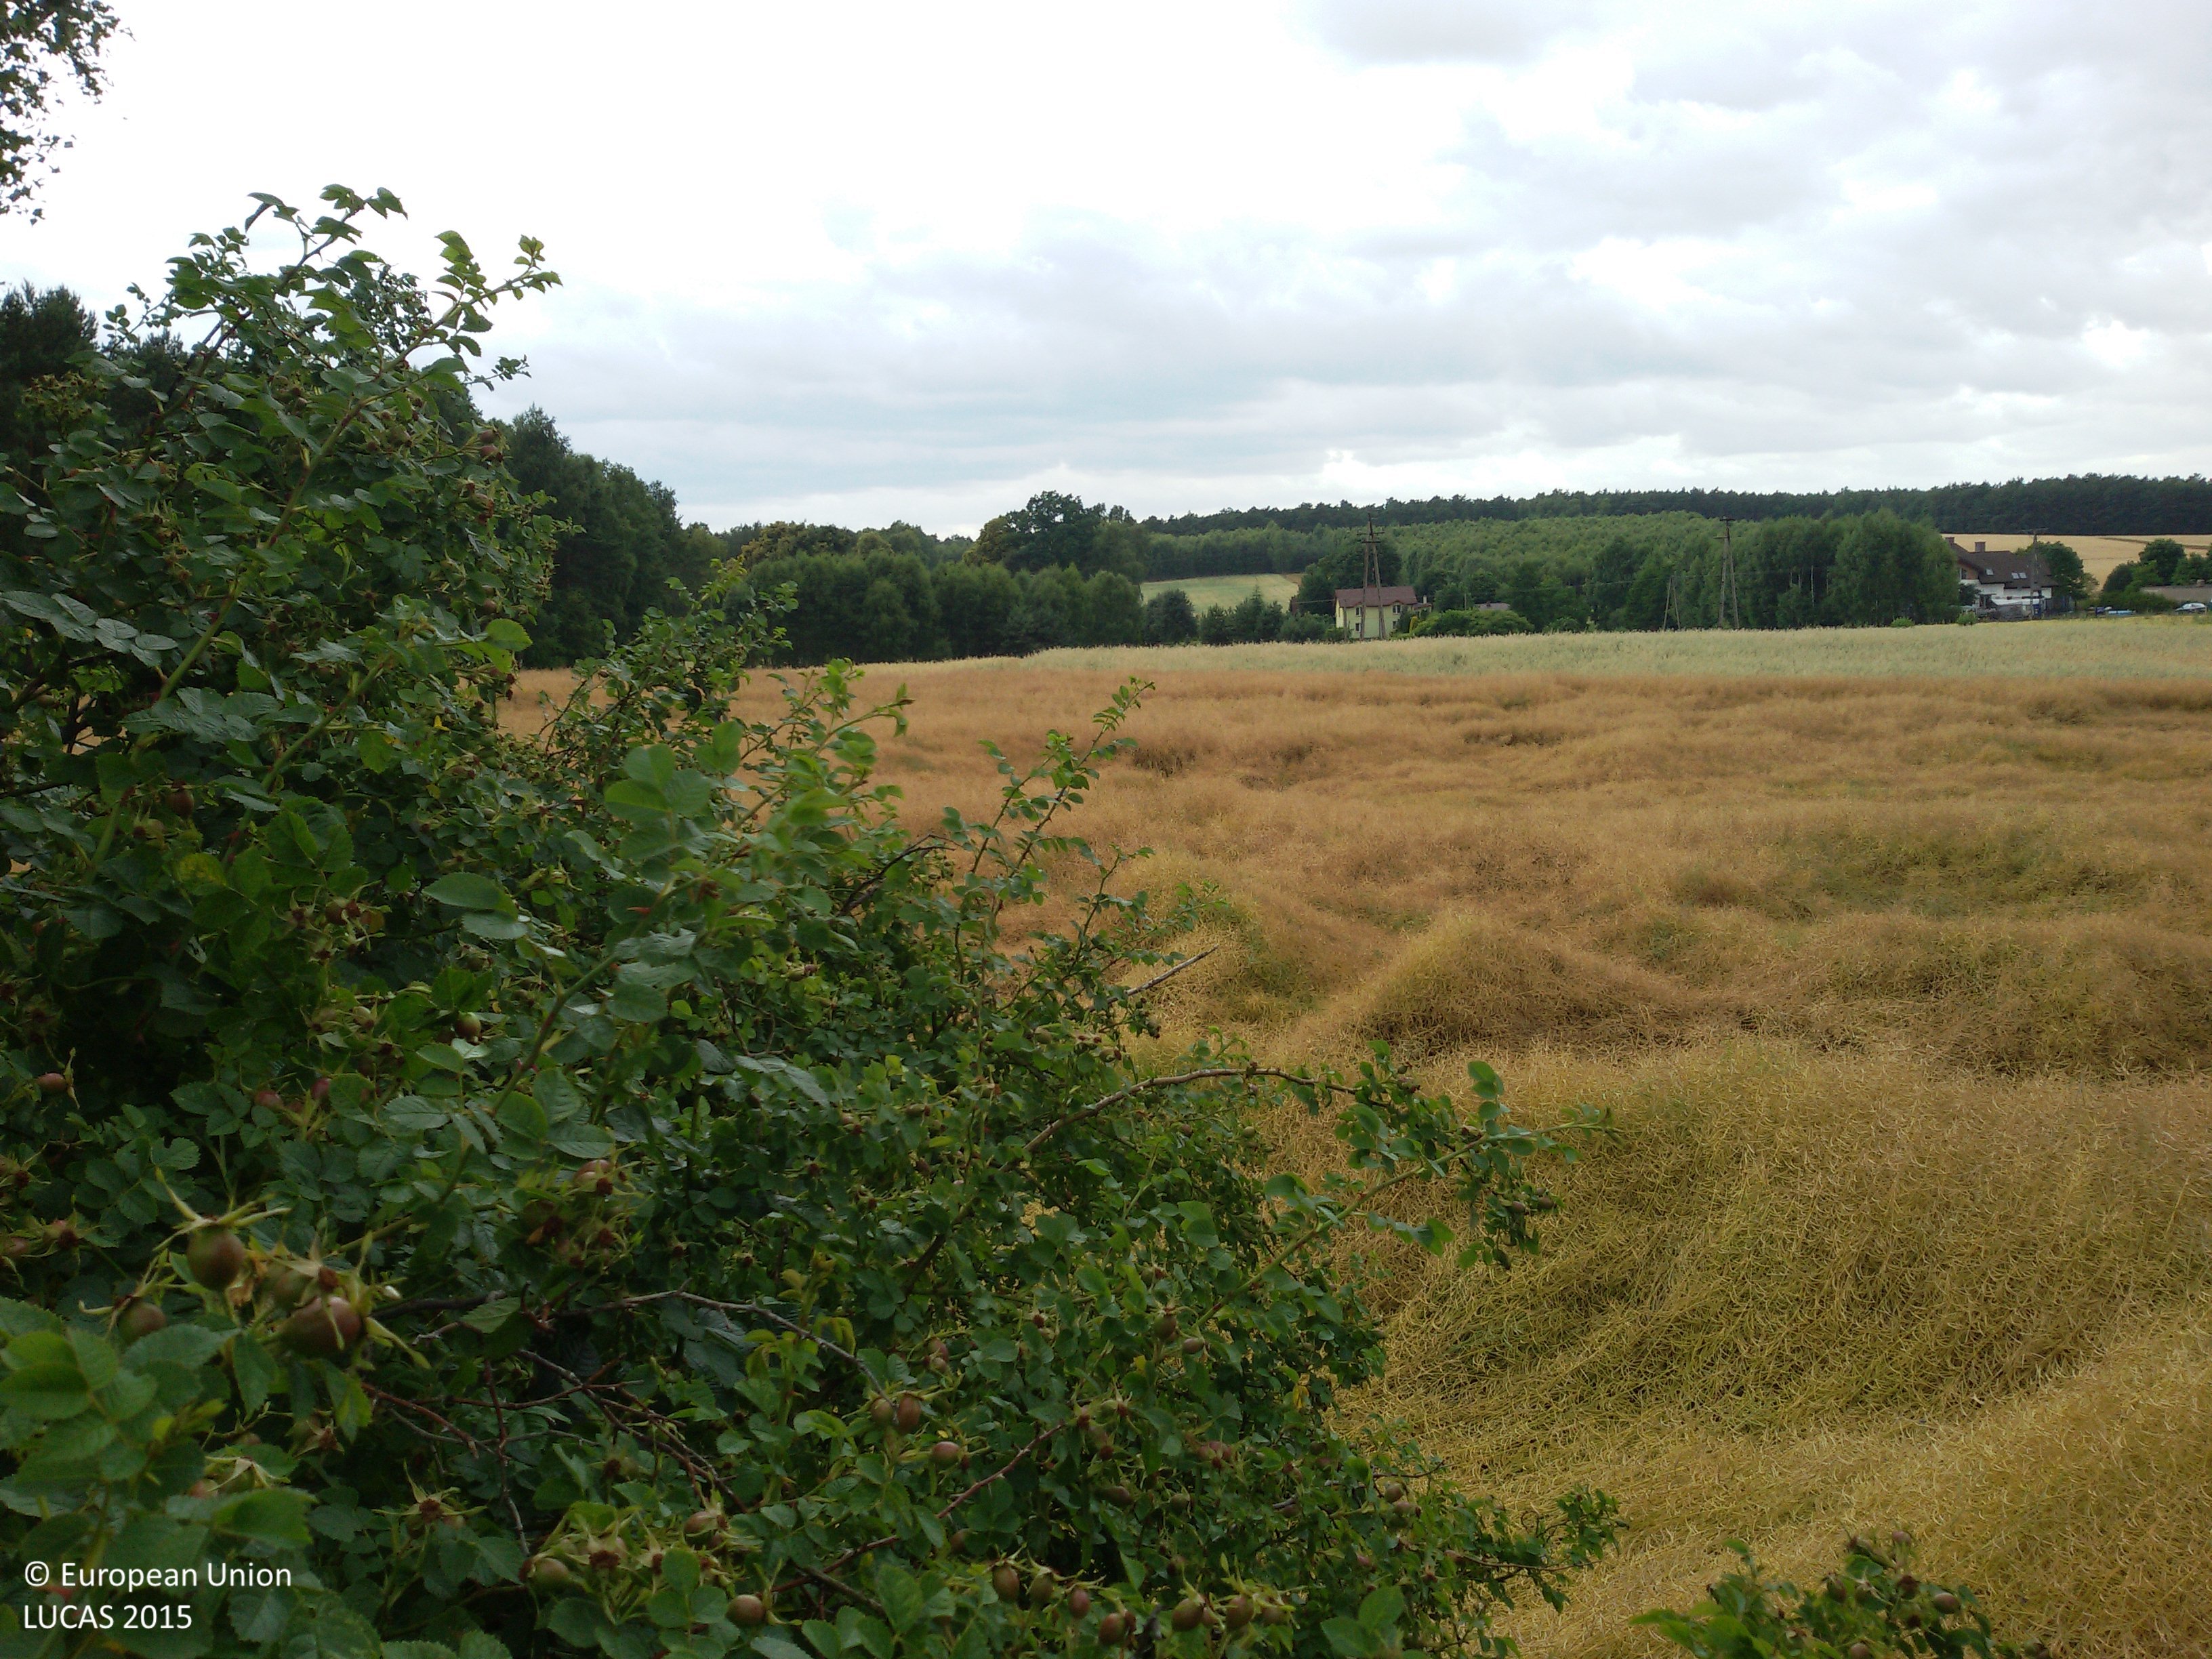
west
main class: Shrubland
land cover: Shrubland with sparse tree cover
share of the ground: > 75 %
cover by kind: shrubs 85 %, herbaceous plants 10 %, broadleaved forest trees 5 %
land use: Abandoned areas
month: July
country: PL
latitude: 51.7861
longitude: 19.8455
